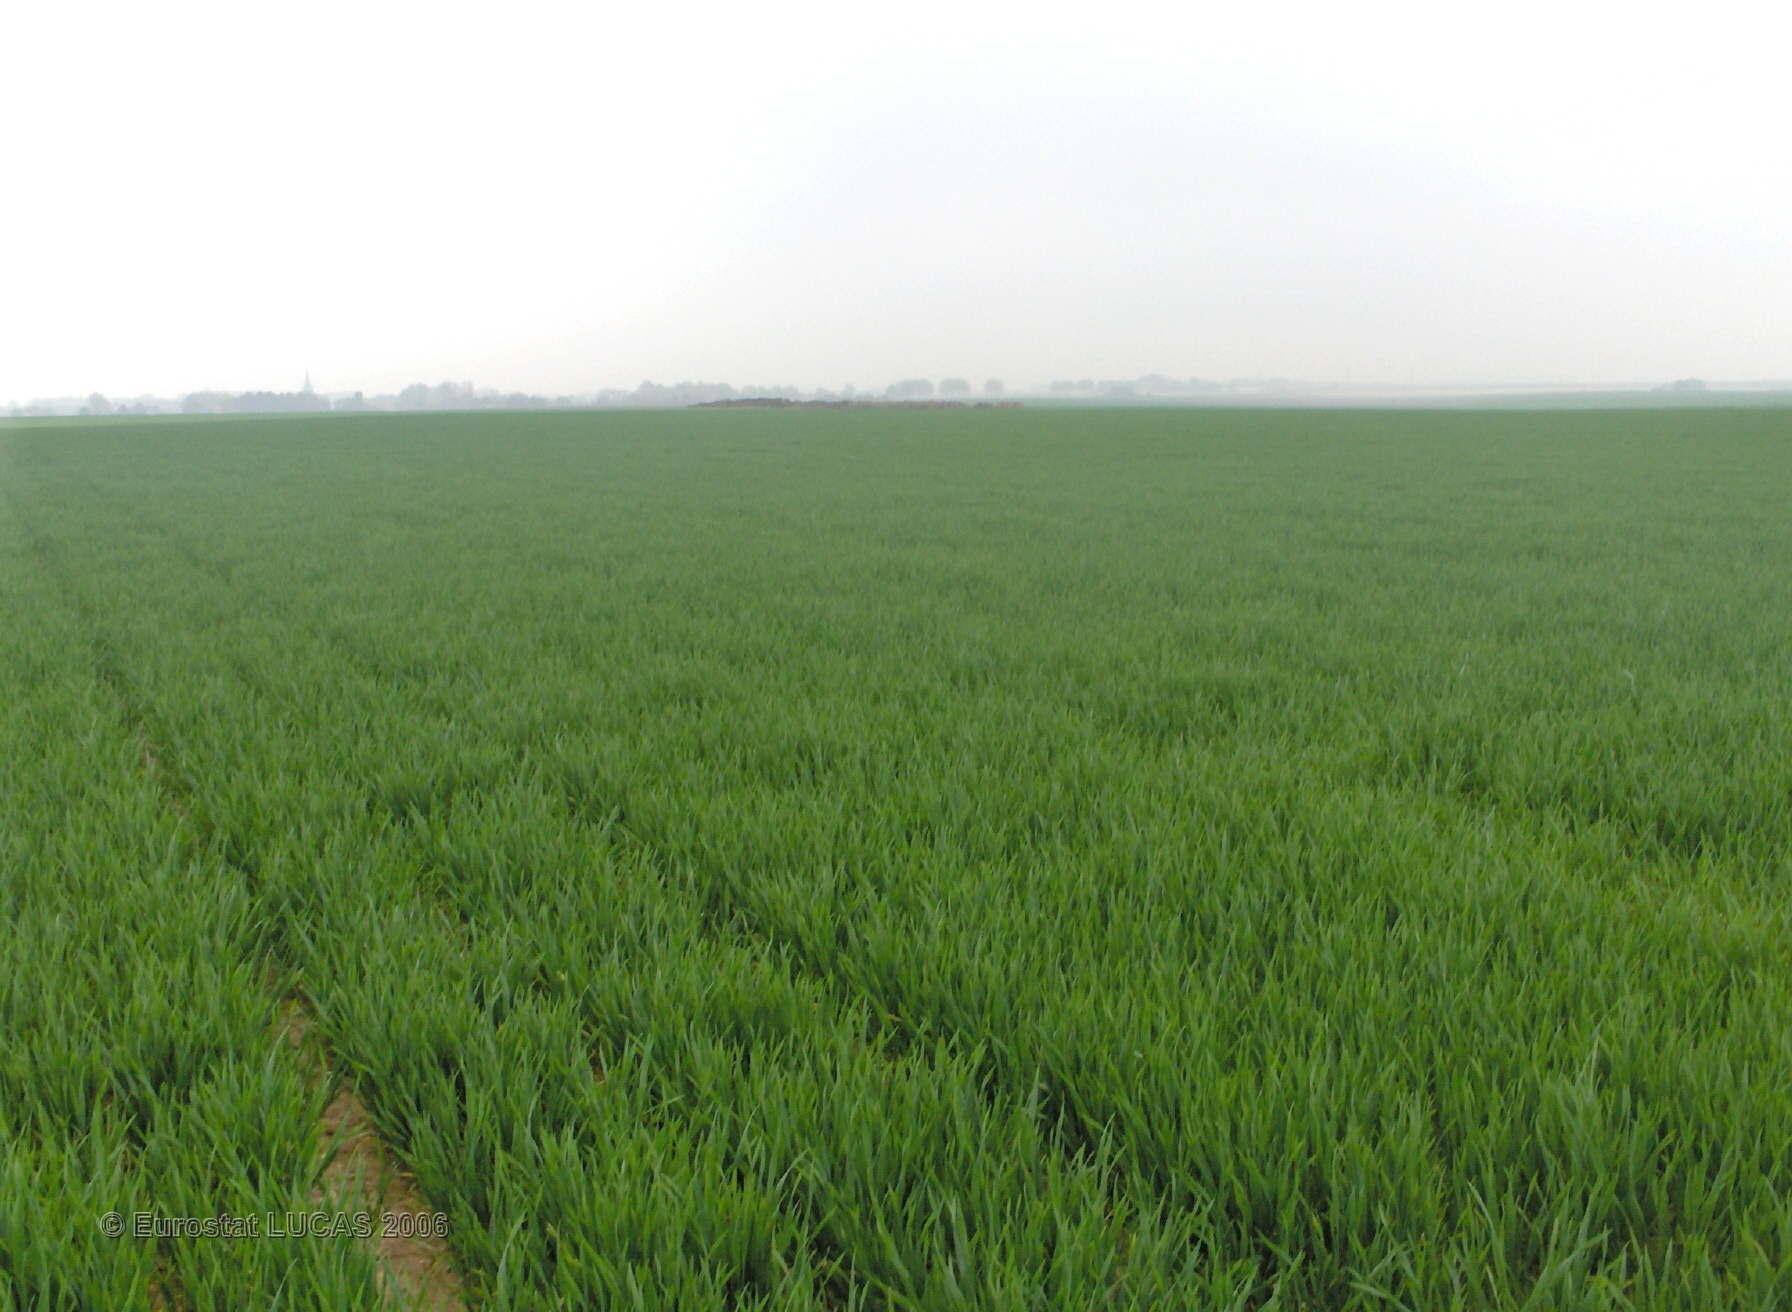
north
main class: Cropland
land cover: Common wheat
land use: Agriculture (excluding fallow land and kitchen gardens)
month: May
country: BE
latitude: 50.5385
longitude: 4.5071
